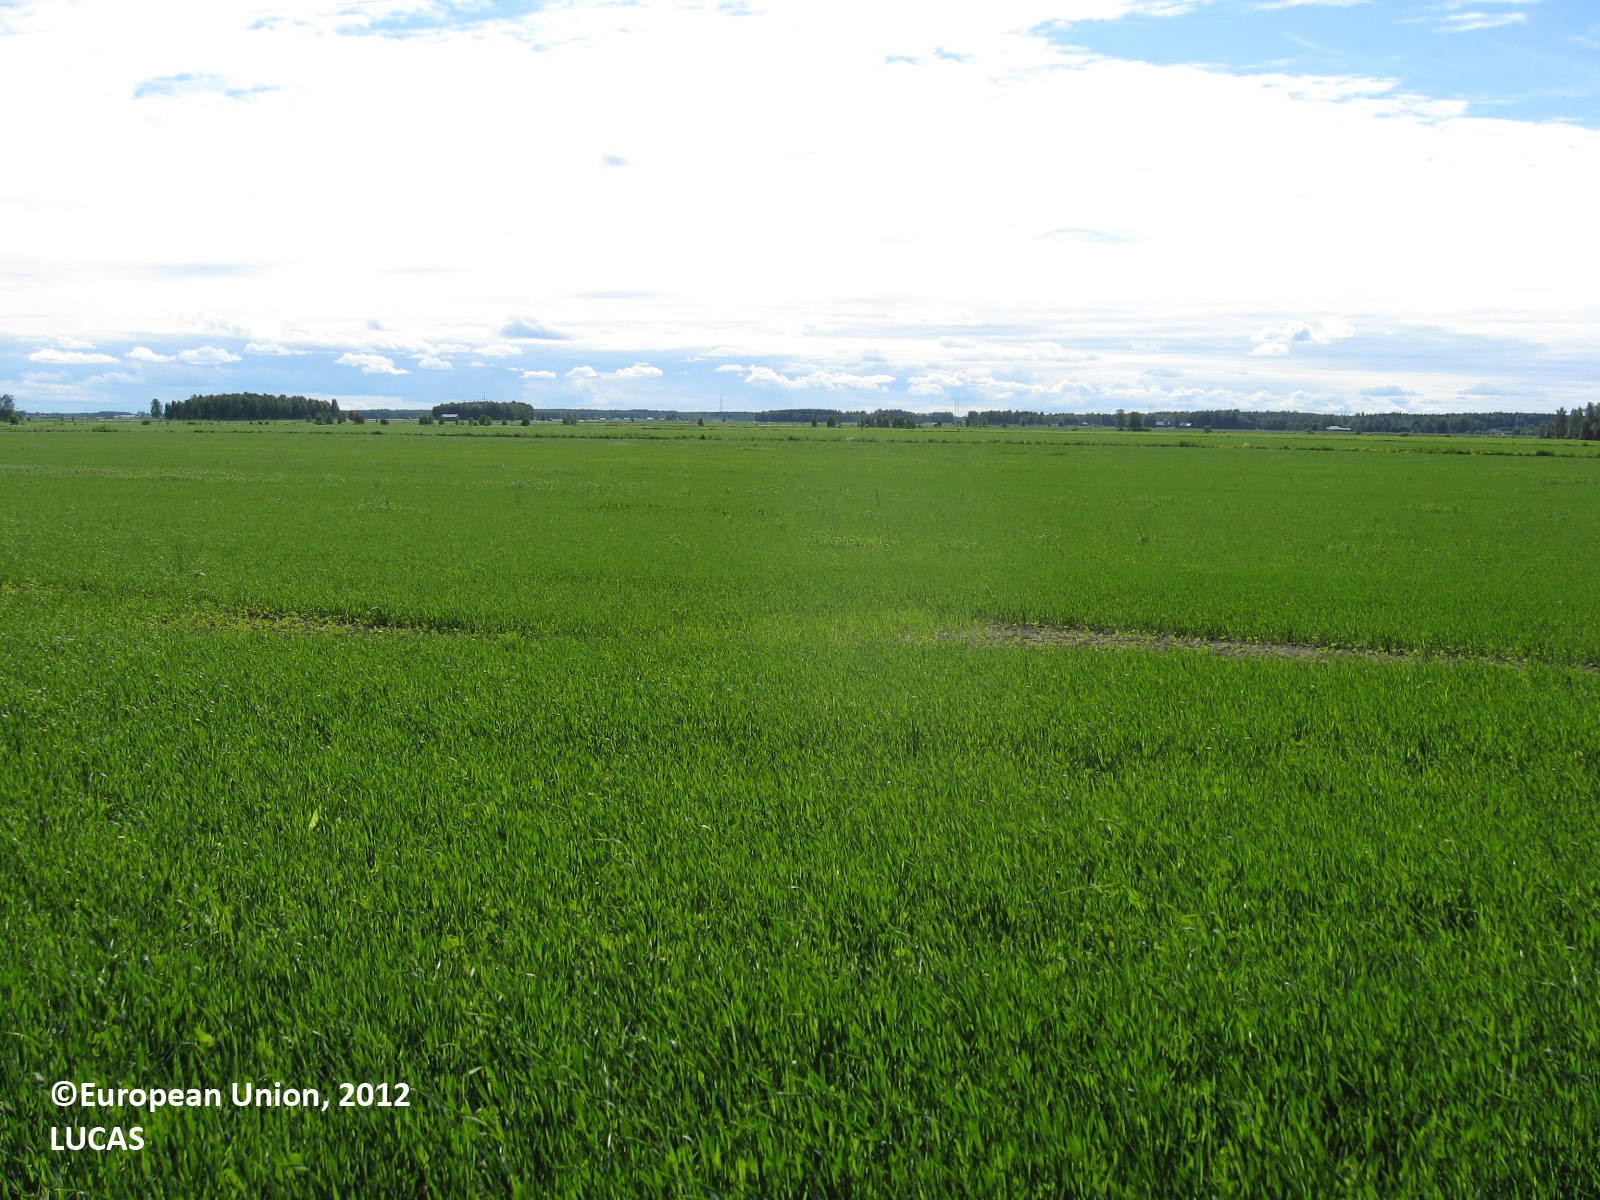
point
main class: Cropland
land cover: Barley
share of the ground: > 75 %
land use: Agriculture (excluding fallow land and kitchen gardens)
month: June
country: FI
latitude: 62.8248
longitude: 22.6751
